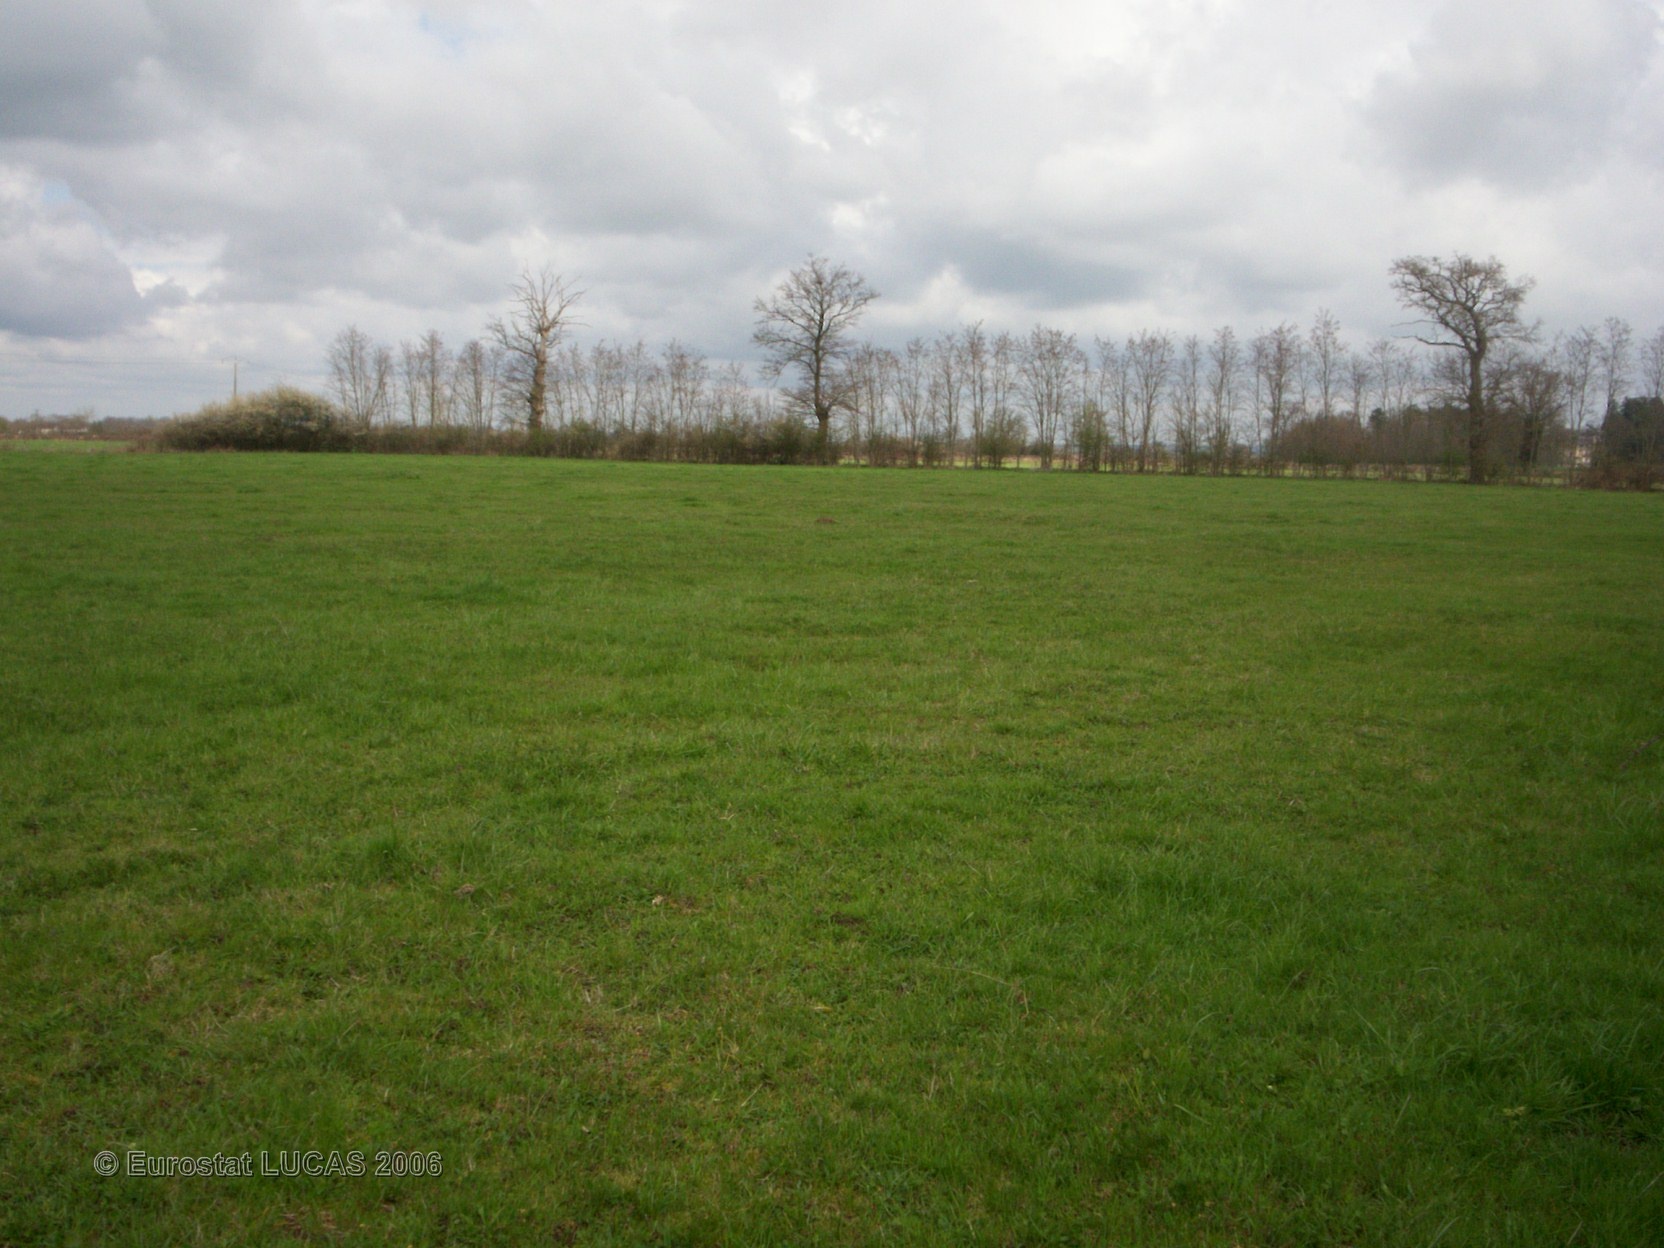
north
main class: Grassland
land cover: Grassland without tree/shrub cover
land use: Agriculture (excluding fallow land and kitchen gardens)
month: April
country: FR
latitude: 46.8323
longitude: 3.0874
